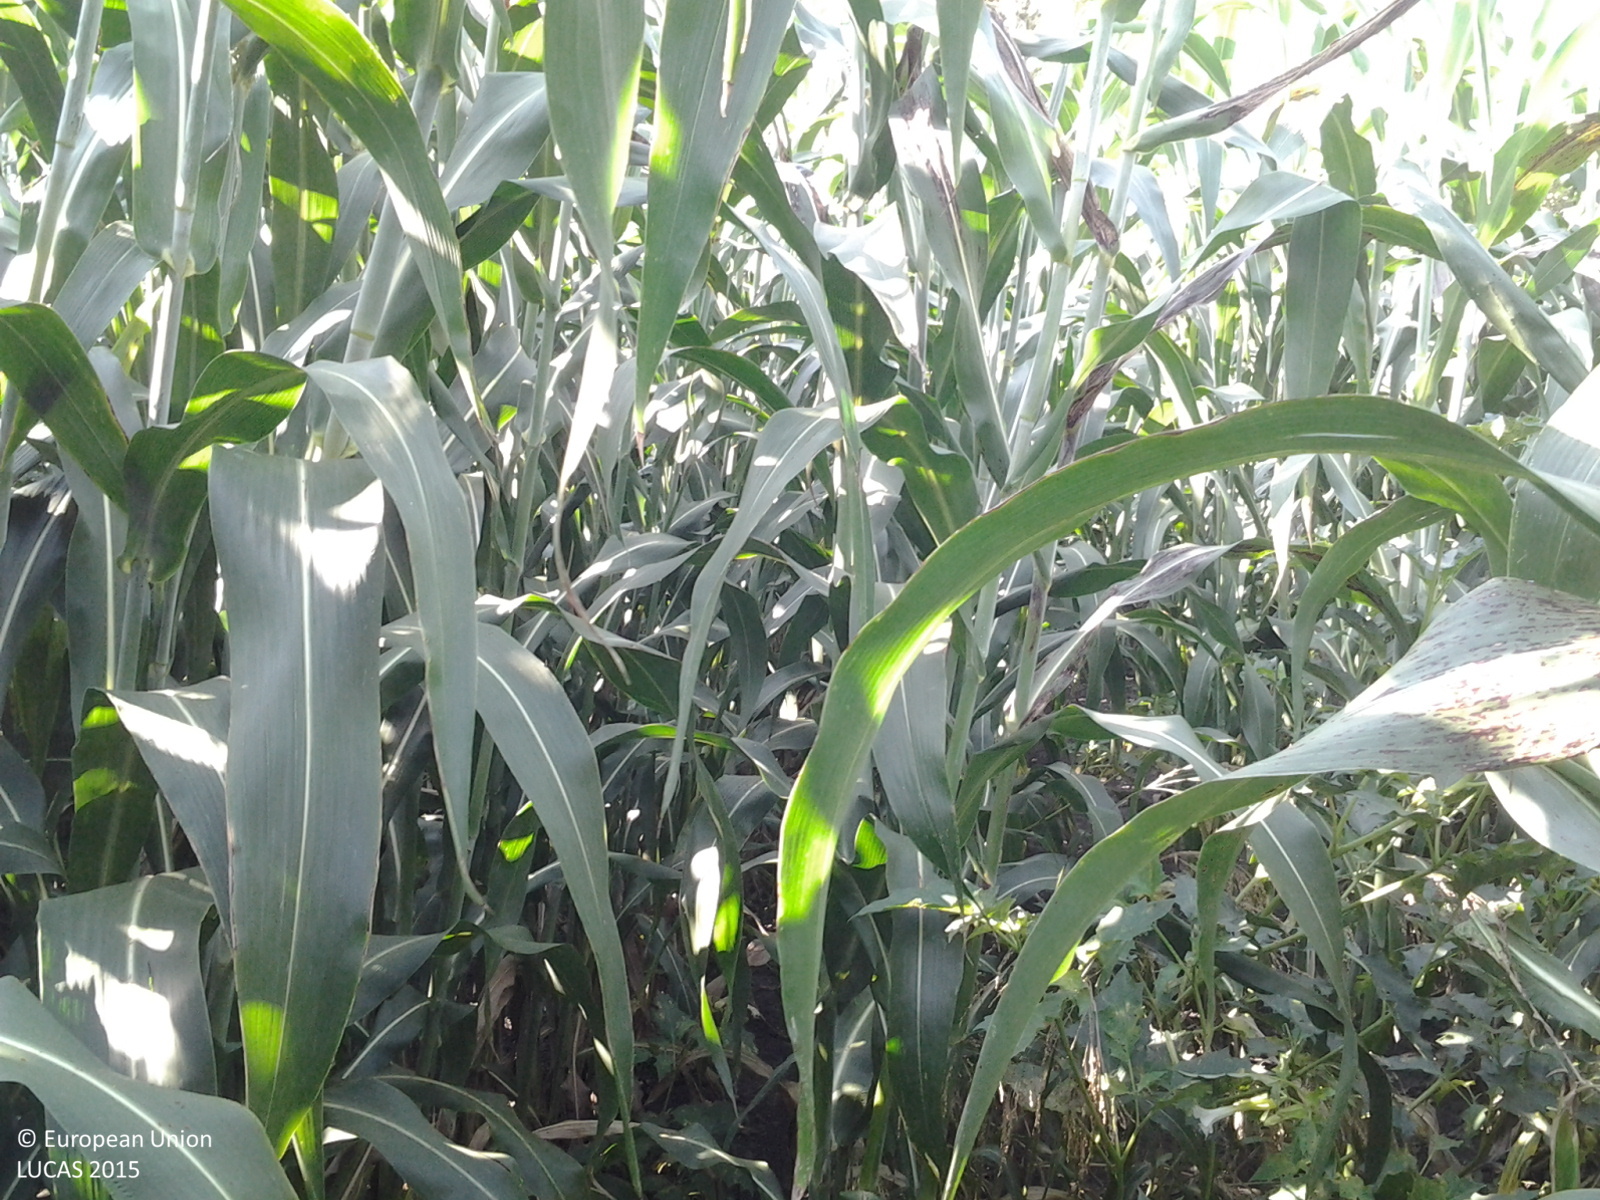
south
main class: Cropland
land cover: Other cereals
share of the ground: > 75 %
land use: Agriculture (excluding fallow land and kitchen gardens)
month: August
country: HU
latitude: 47.1803
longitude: 19.8806
